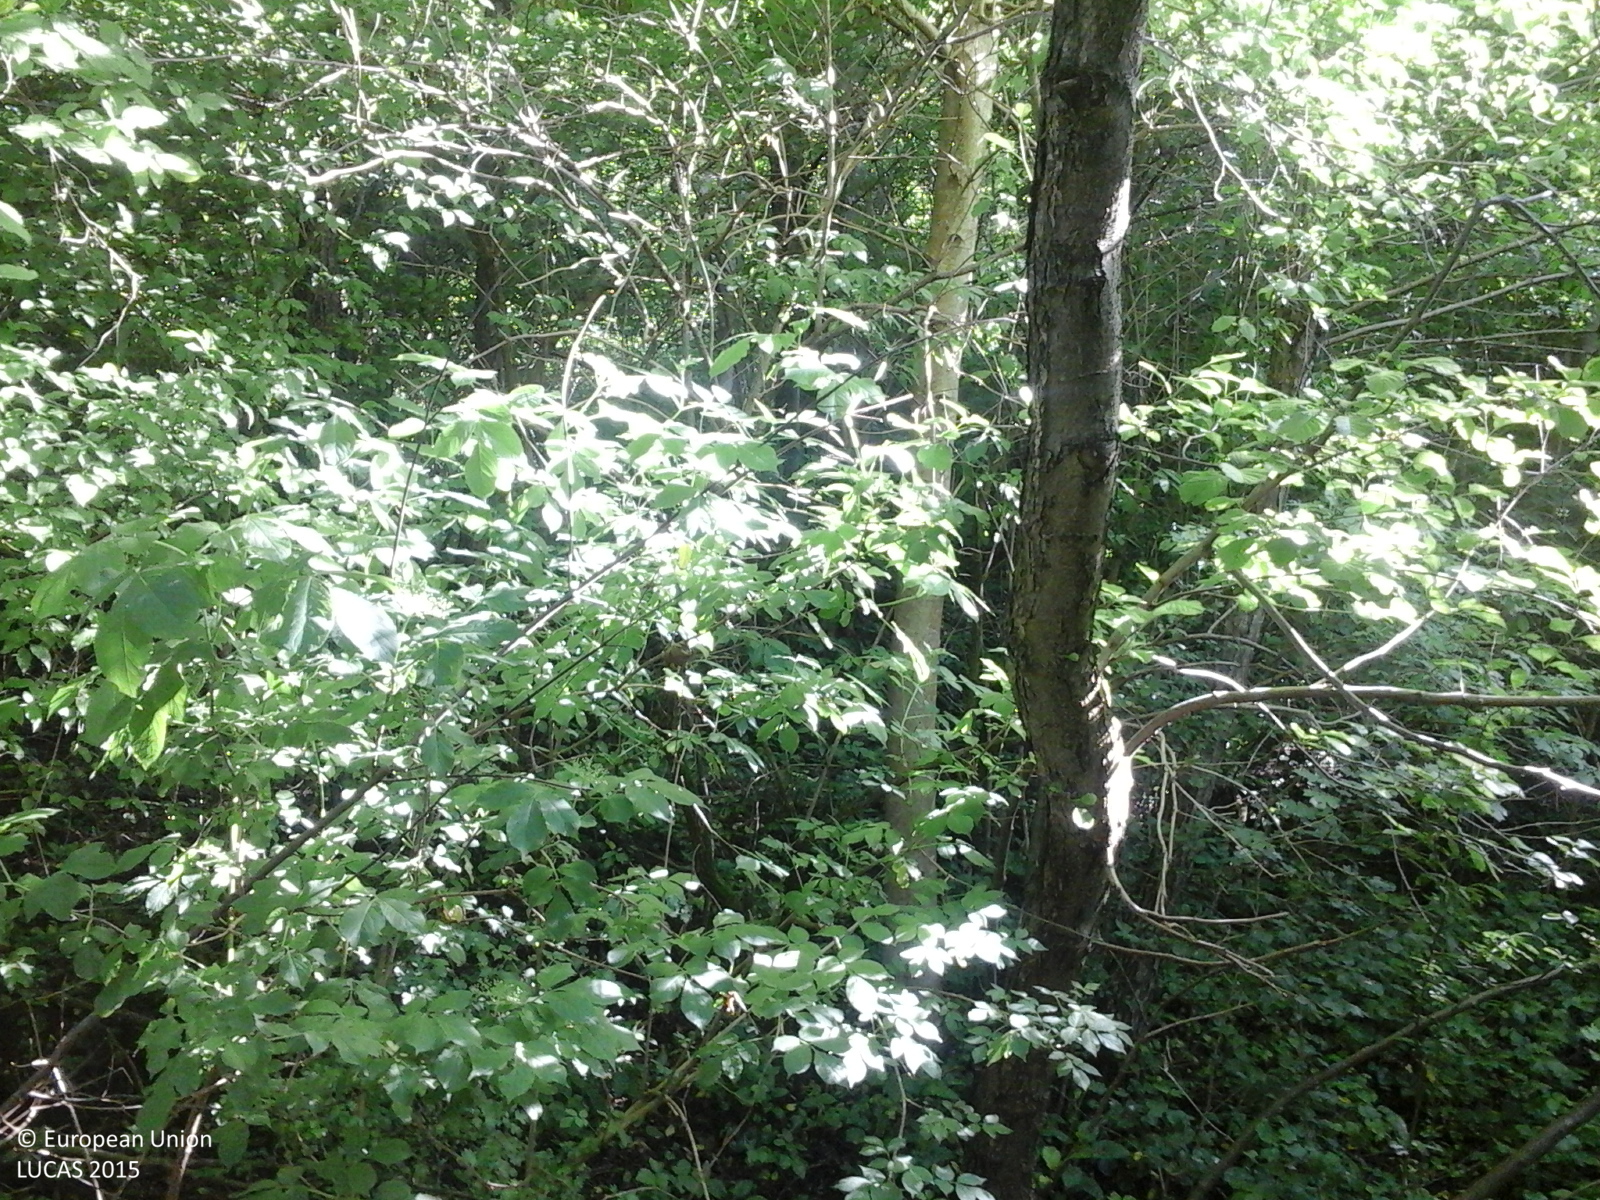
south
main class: Woodland
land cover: Broadleaved woodland
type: mesophytic deciduous forest
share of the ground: > 75 %
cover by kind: broadleaved forest trees 100 %
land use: Forestry
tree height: > 5 m
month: May
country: RO
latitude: 45.2026
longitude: 26.1678
